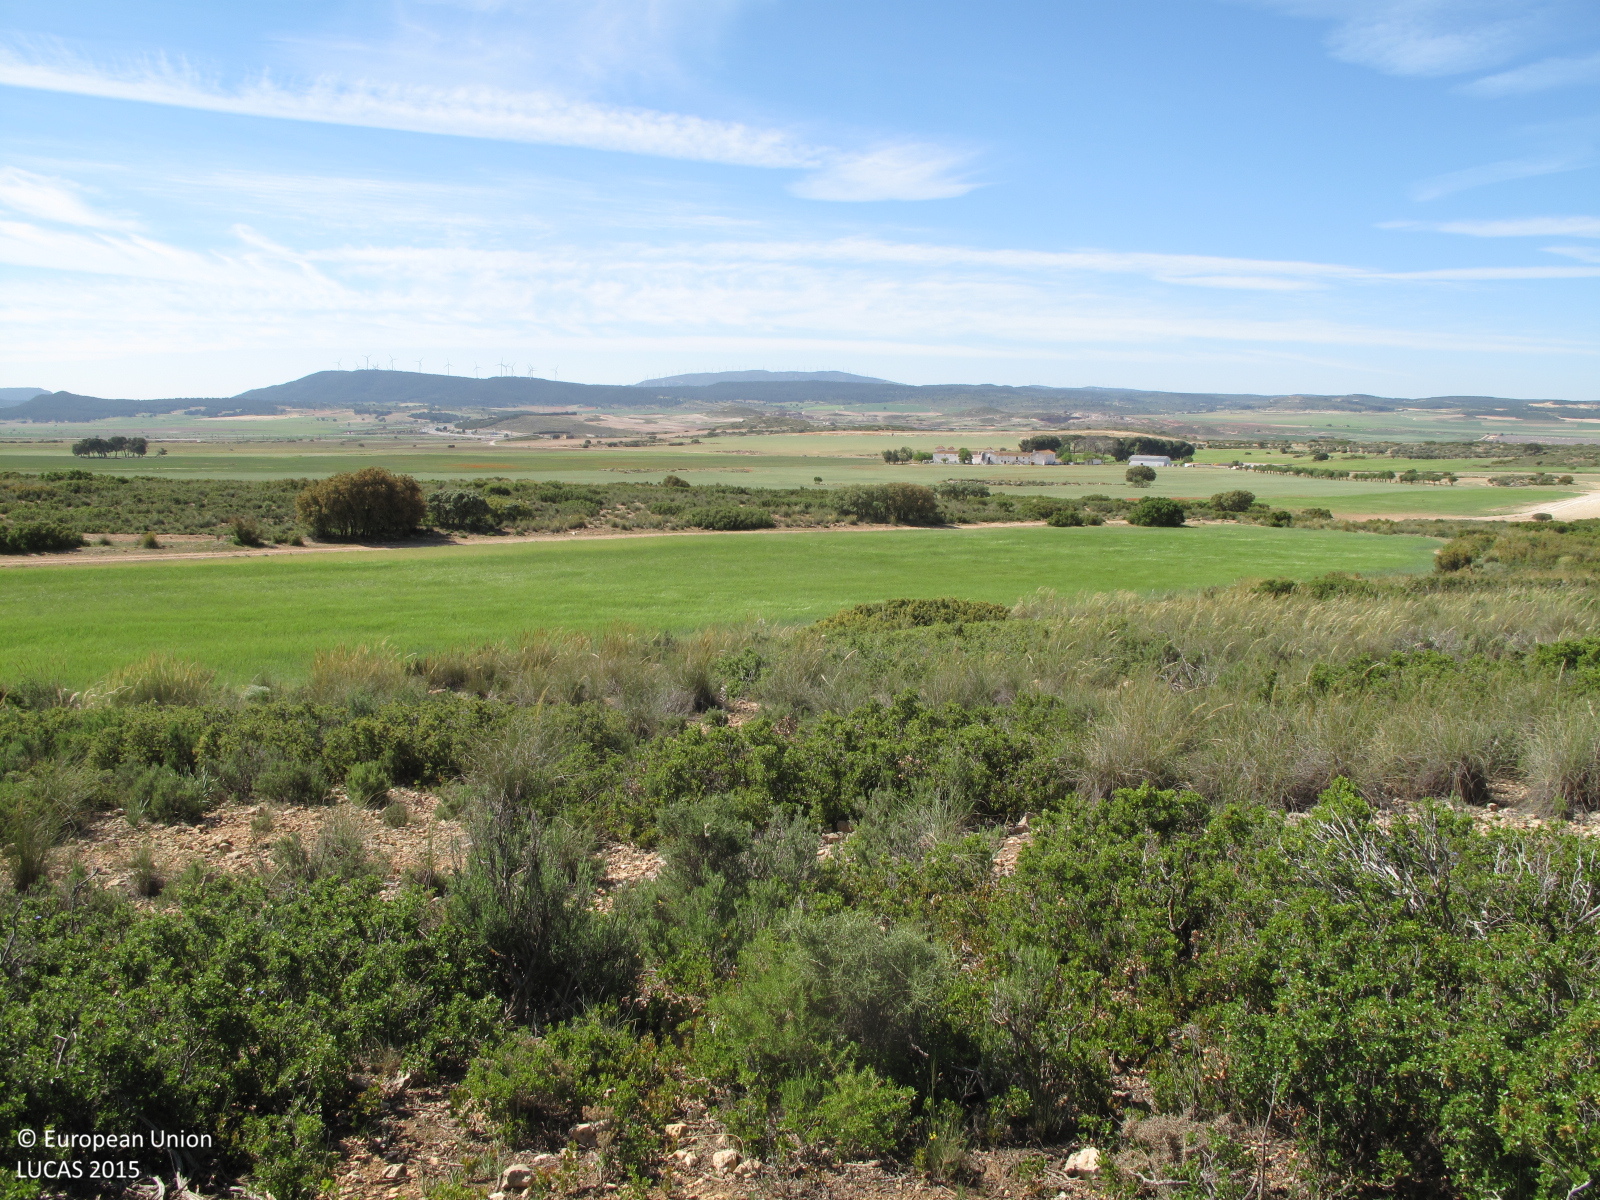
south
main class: Shrubland
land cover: Shrubland with sparse tree cover
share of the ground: 25 - 50 %
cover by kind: consolidated bare surface 45 %, shrubs 40 %, herbaceous plants 10 %, broadleaved forest trees 5 %
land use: Semi-natural and natural areas not in use
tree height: > 5 m
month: May
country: ES
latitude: 38.8773
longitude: -1.0250
